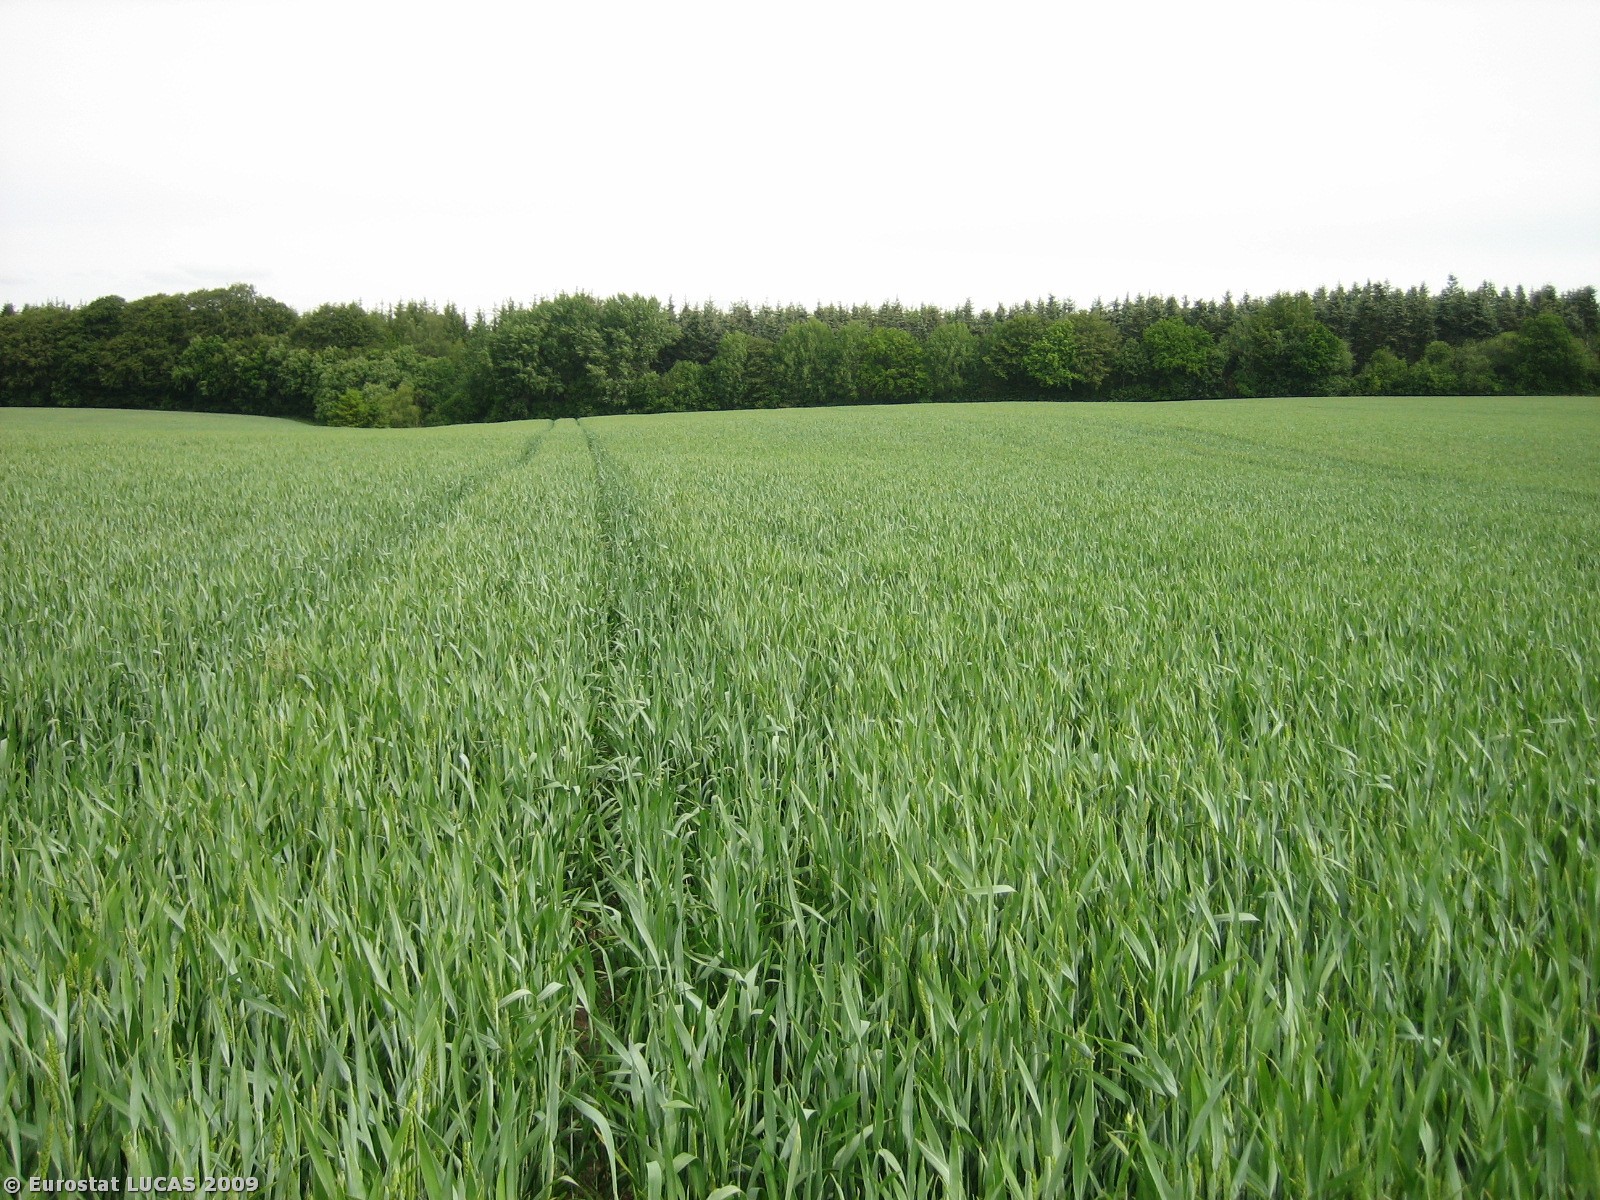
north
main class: Cropland
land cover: Common wheat
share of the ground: > 75 %
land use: Agriculture (excluding fallow land and kitchen gardens)
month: June
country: DK
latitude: 56.2596
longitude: 10.0161
